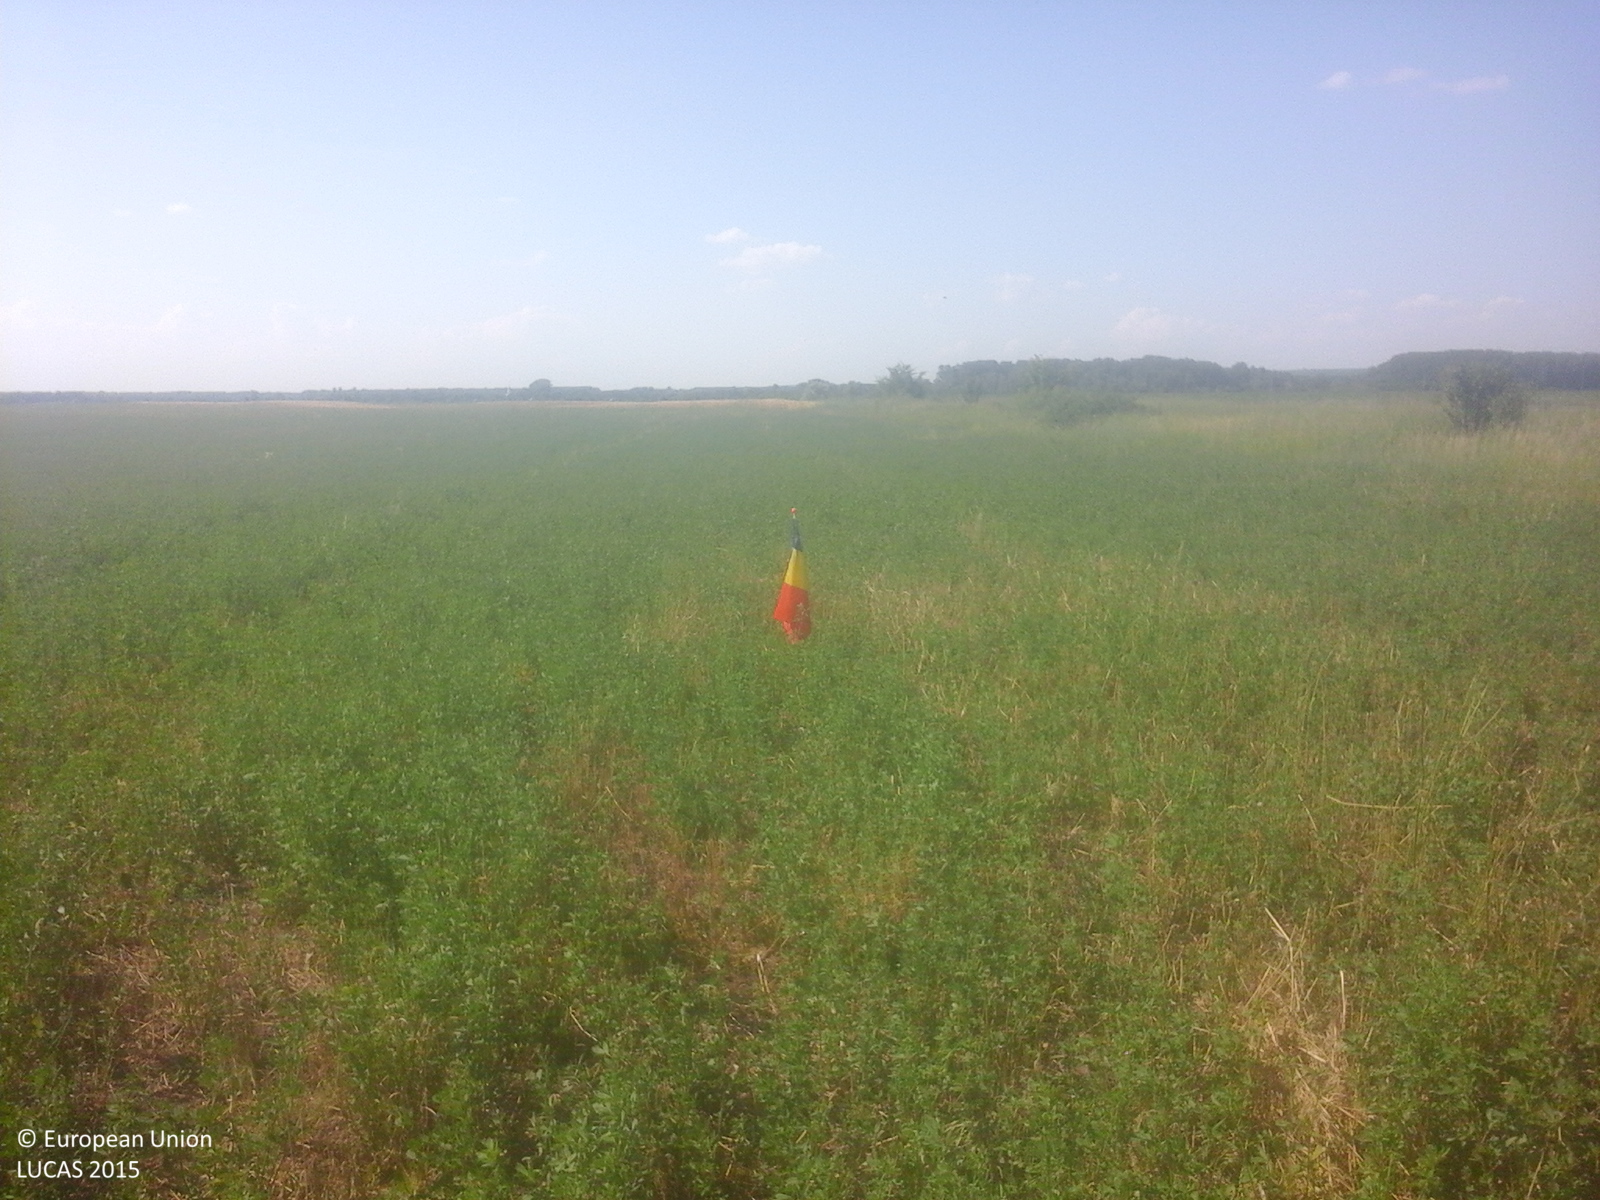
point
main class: Cropland
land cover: Lucerne
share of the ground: > 75 %
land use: Agriculture (excluding fallow land and kitchen gardens)
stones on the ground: < 10 %
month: June
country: RO
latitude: 47.2747
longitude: 27.6905
